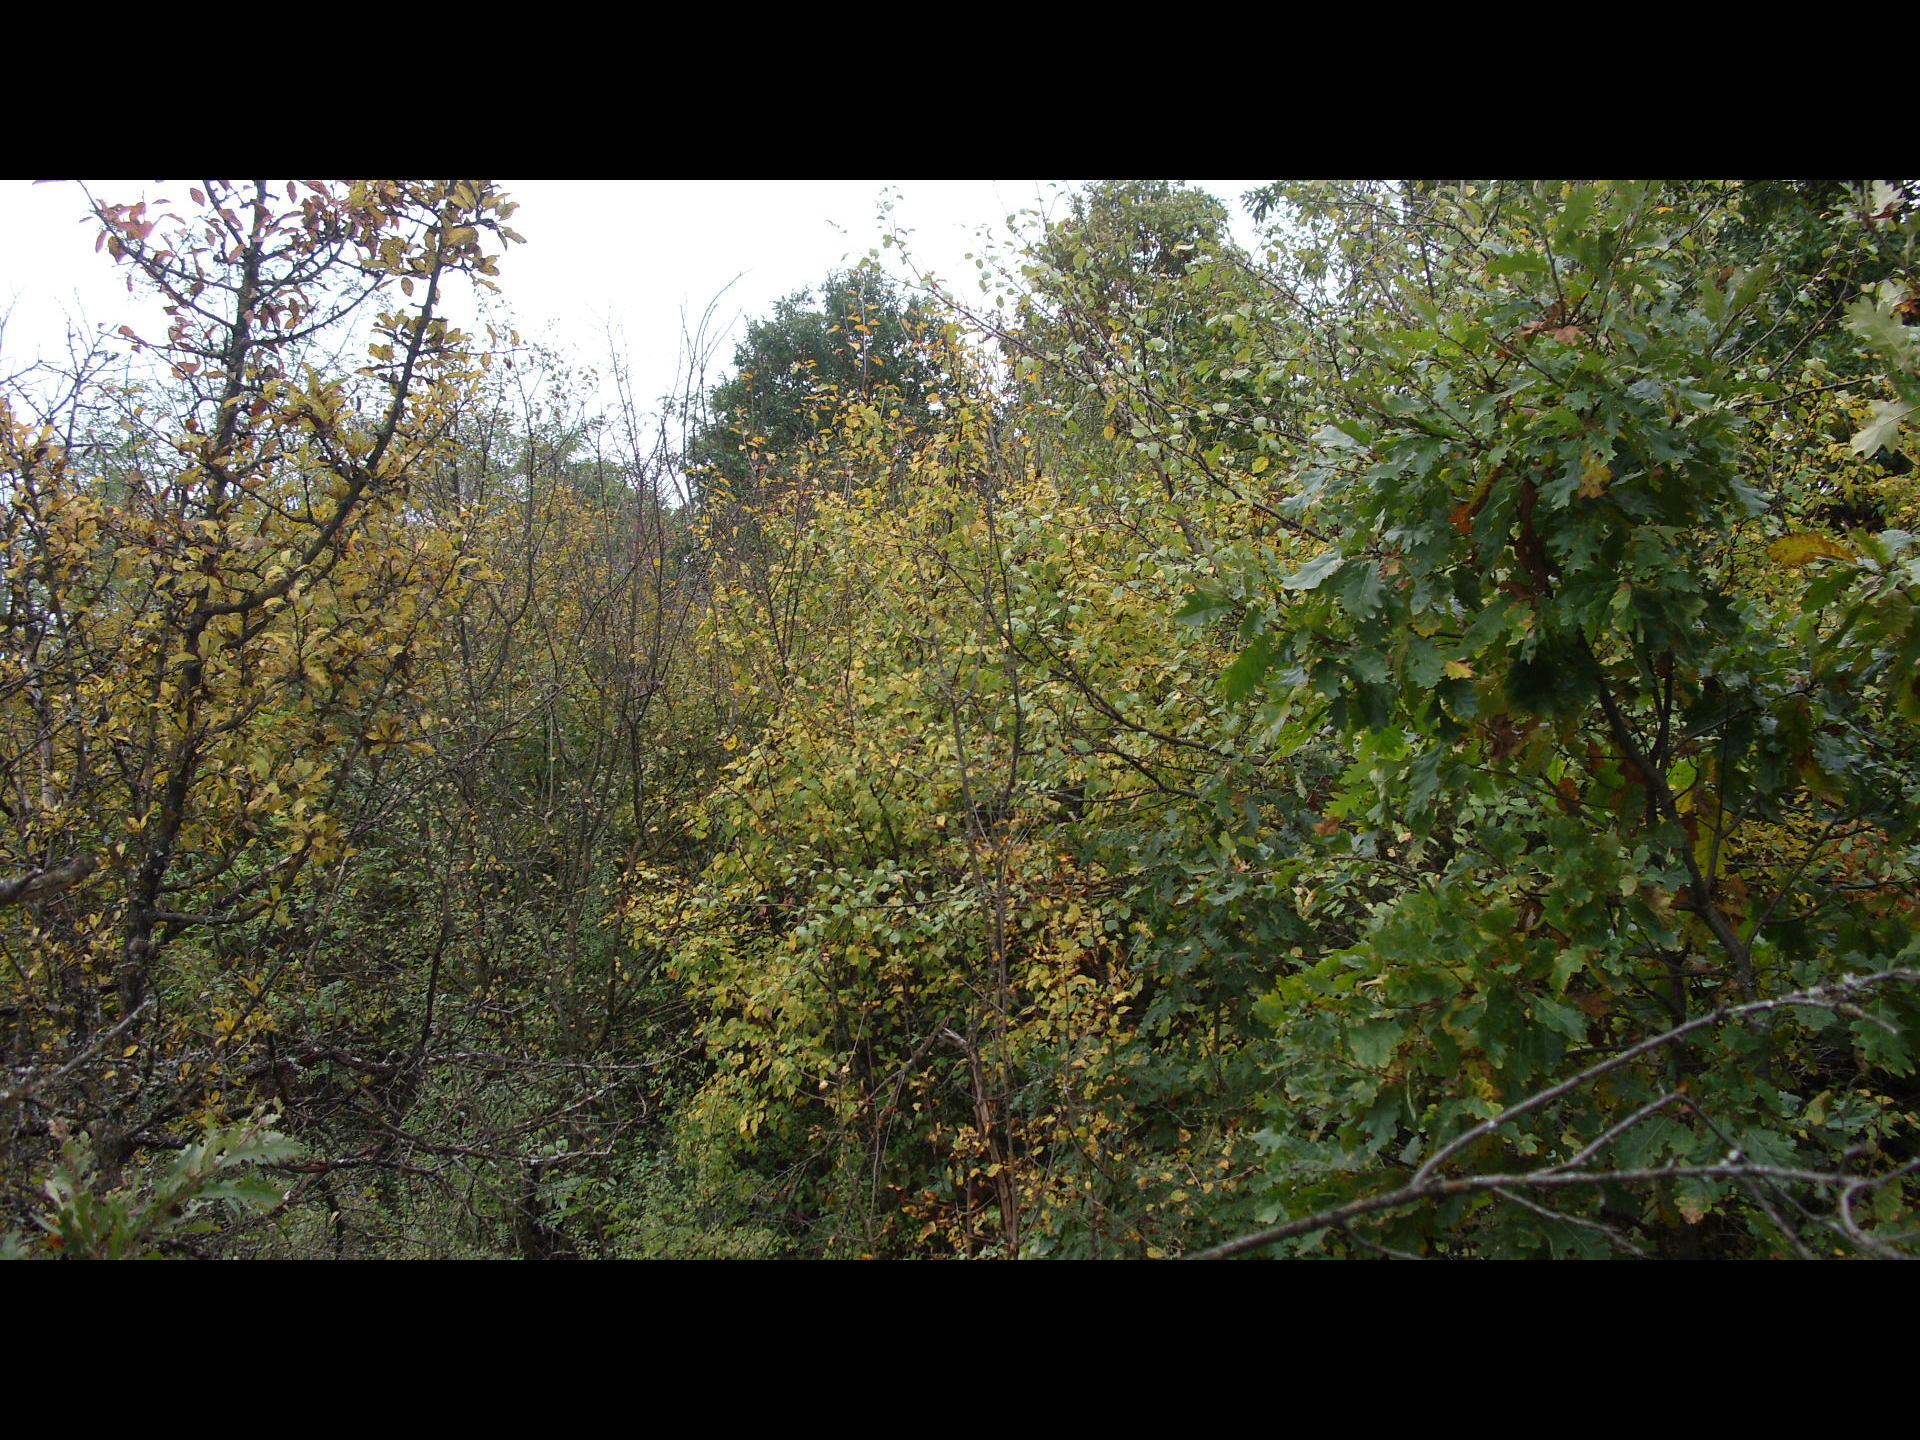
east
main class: Shrubland
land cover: Shrubland with sparse tree cover
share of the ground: > 75 %
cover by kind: shrubs 85 %, herbaceous plants 10 %, broadleaved forest trees 5 %
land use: Semi-natural and natural areas not in use
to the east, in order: Shrubland with sparse tree cover; Broadleaved woodland; Rivers and streams; Broadleaved woodland; Grassland with sparse tree/shrub cover; Grassland without tree/shrub cover
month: October
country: BG
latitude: 43.6707
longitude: 22.5968
